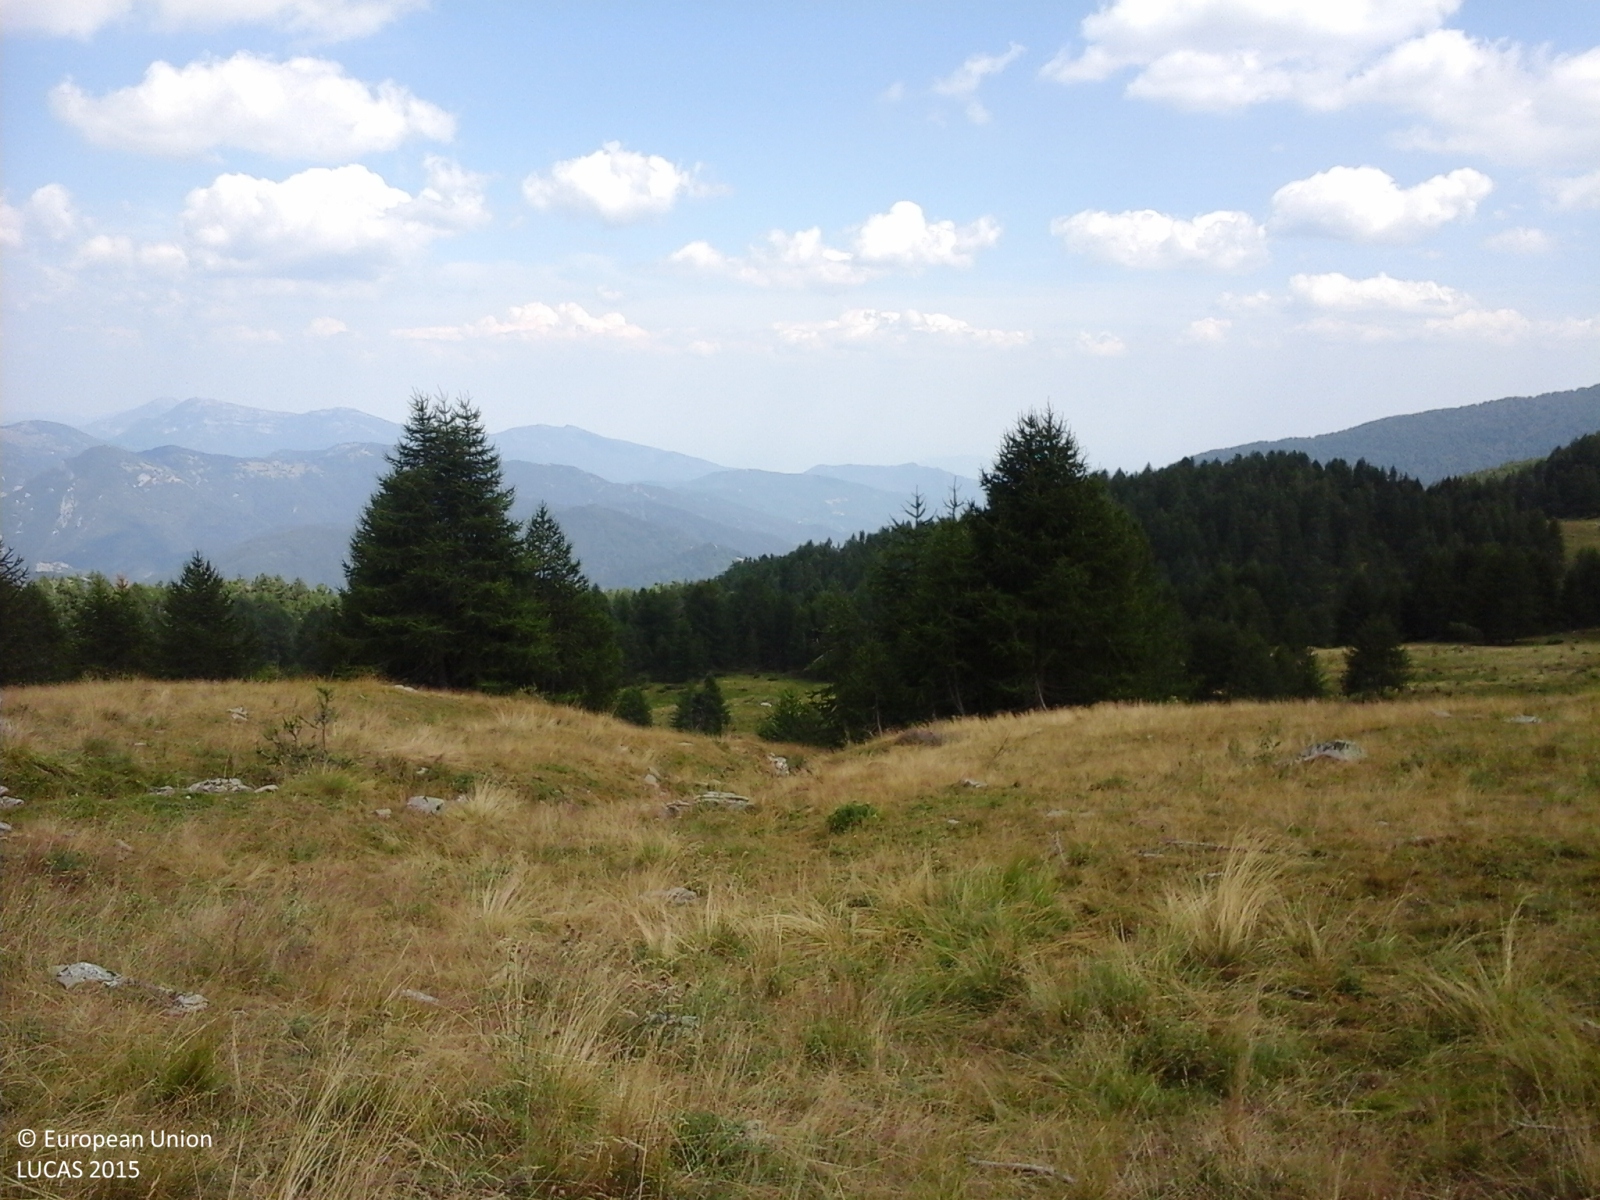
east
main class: Grassland
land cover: Grassland without tree/shrub cover
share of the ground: > 75 %
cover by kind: herbaceous plants 80 %, consolidated bare surface 20 %
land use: Agriculture (excluding fallow land and kitchen gardens)
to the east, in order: Grassland without tree/shrub cover; Rivers and streams; Grassland without tree/shrub cover; Abandoned hedges; Paved roads, cycling and walking lanes; Dry stone walls; Grassland without tree/shrub cover; Grassland with sparse tree/shrub cover; Rivers and streams; Other coniferous woodland; Grassland with sparse tree/shrub cover
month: August
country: IT
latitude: 44.0909
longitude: 7.7196
